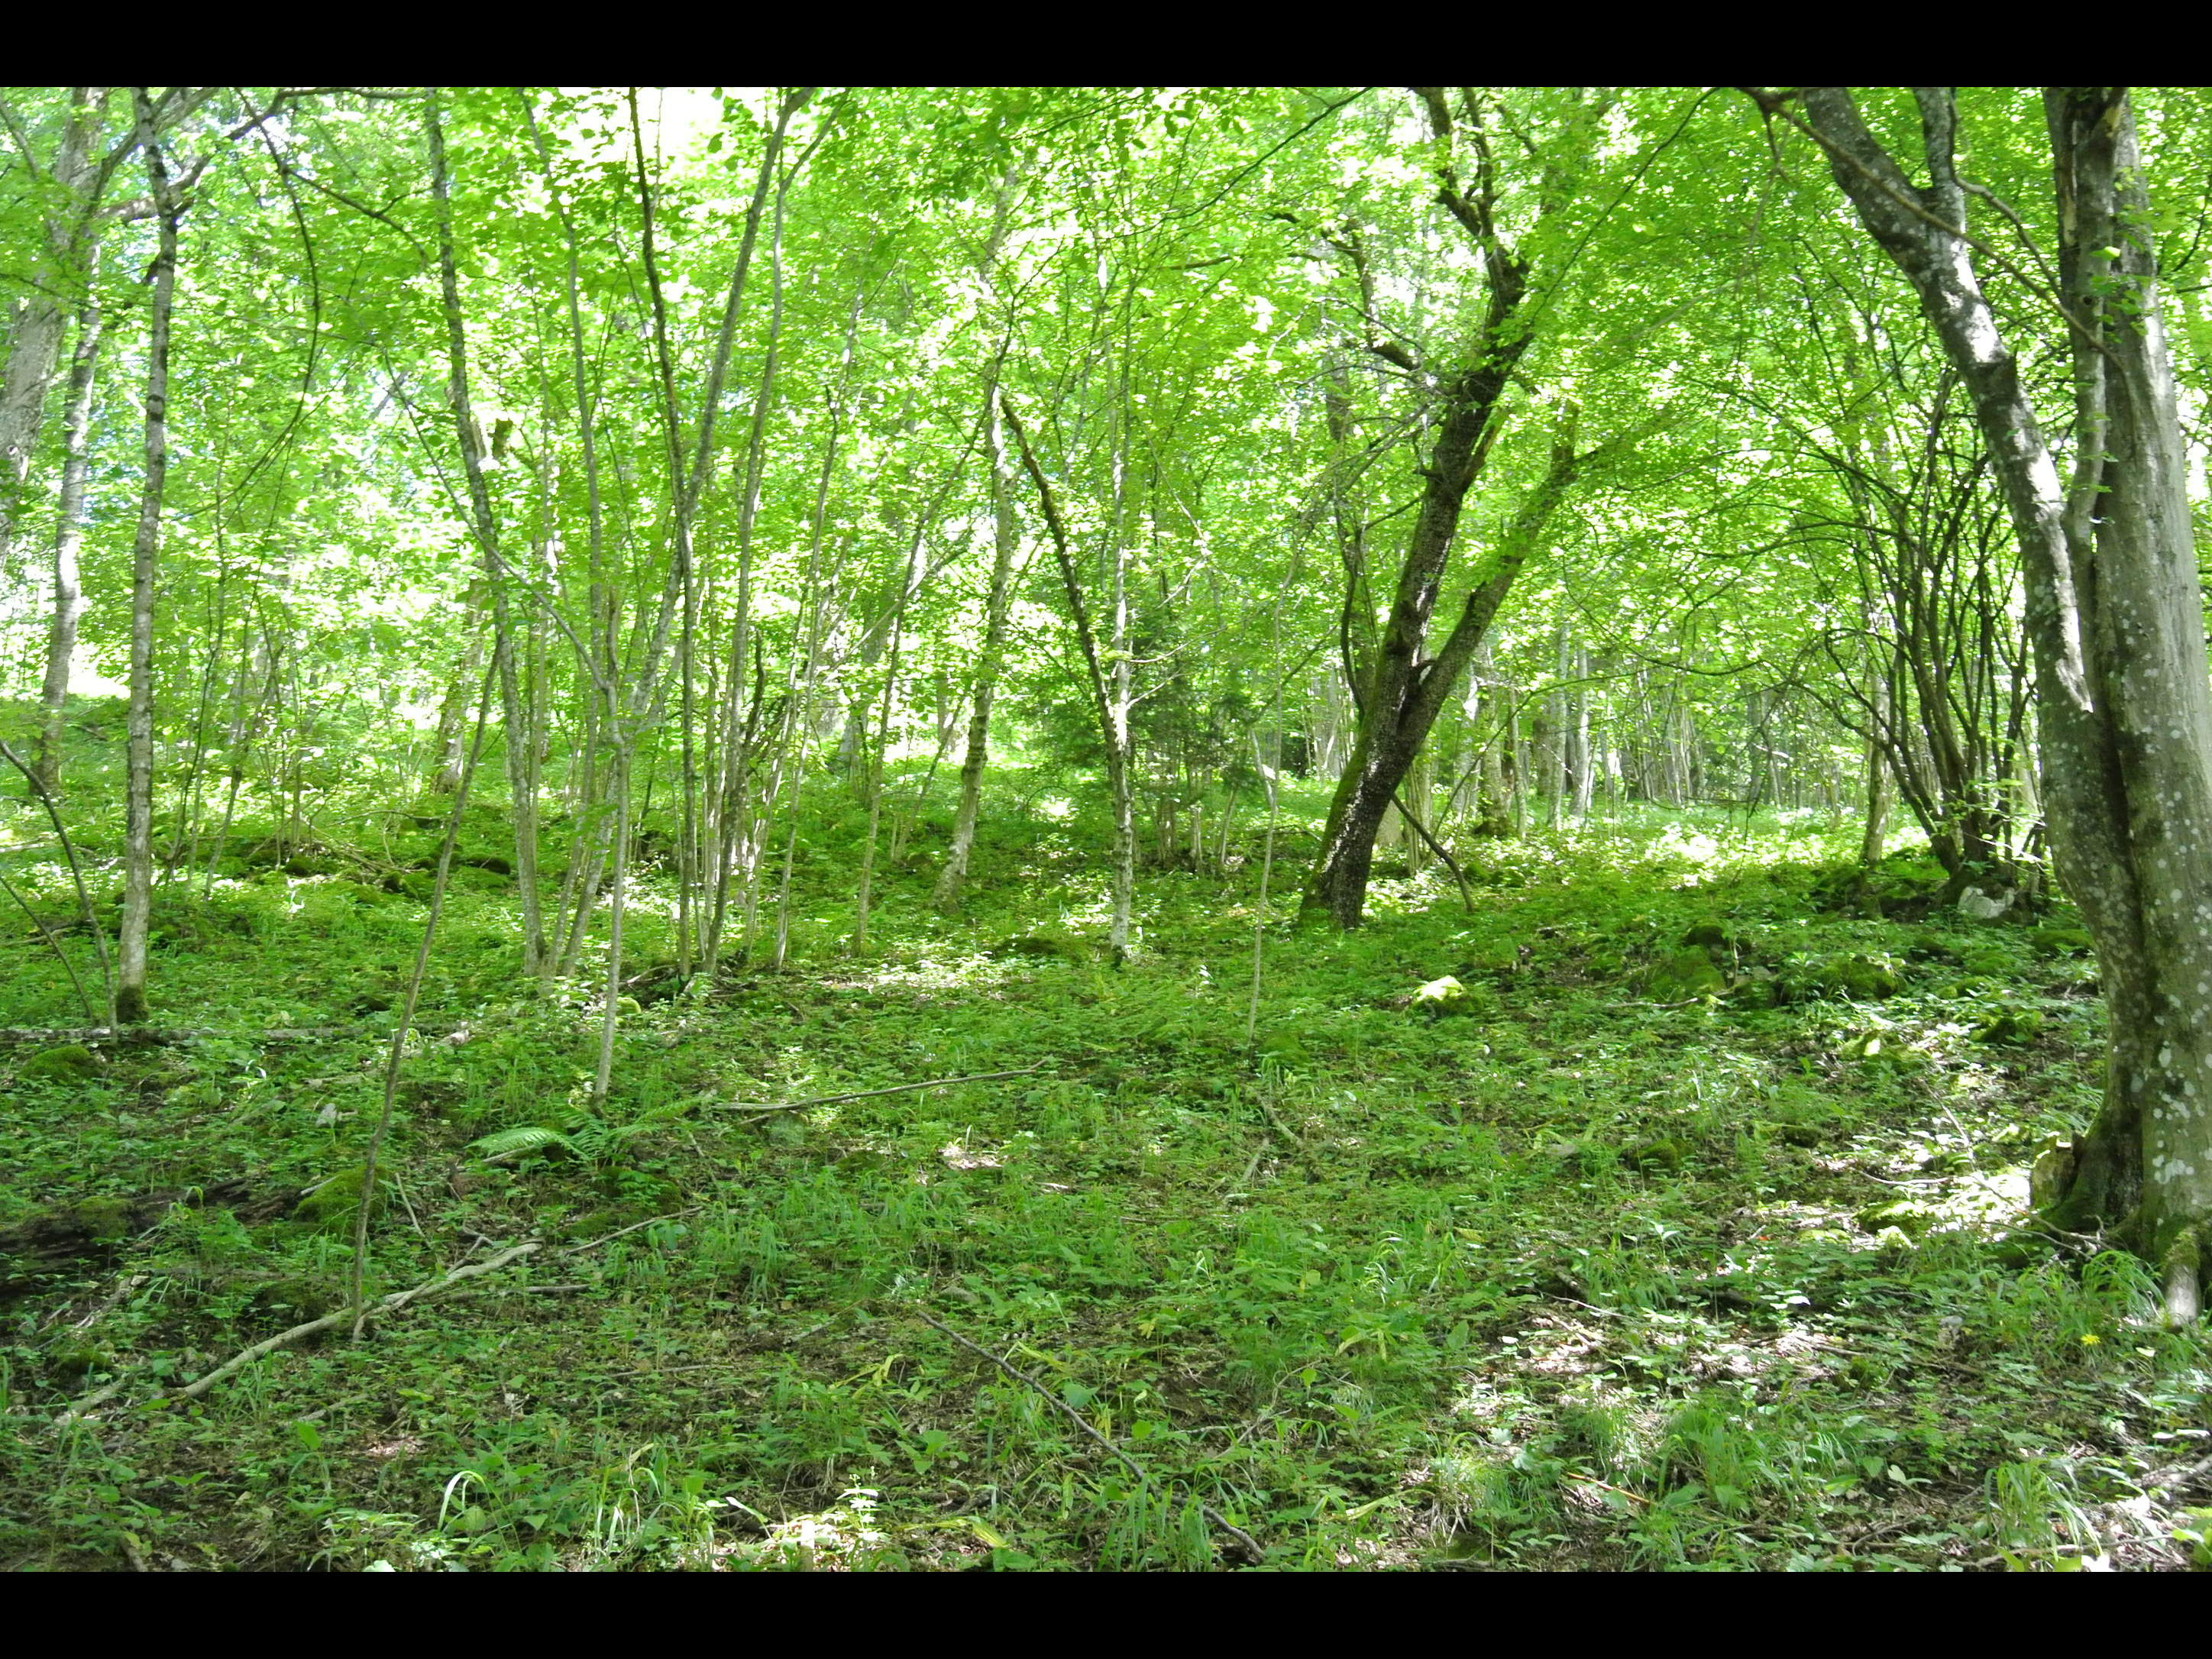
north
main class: Woodland
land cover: Spruce dominated mixed woodland
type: mountainous beech forest
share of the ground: > 75 %
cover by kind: broadleaved forest trees 65 %, coniferous forest trees 35 %
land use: Forestry
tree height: > 5 m
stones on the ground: < 10 %
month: June
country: AT
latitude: 47.9471
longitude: 15.3973
